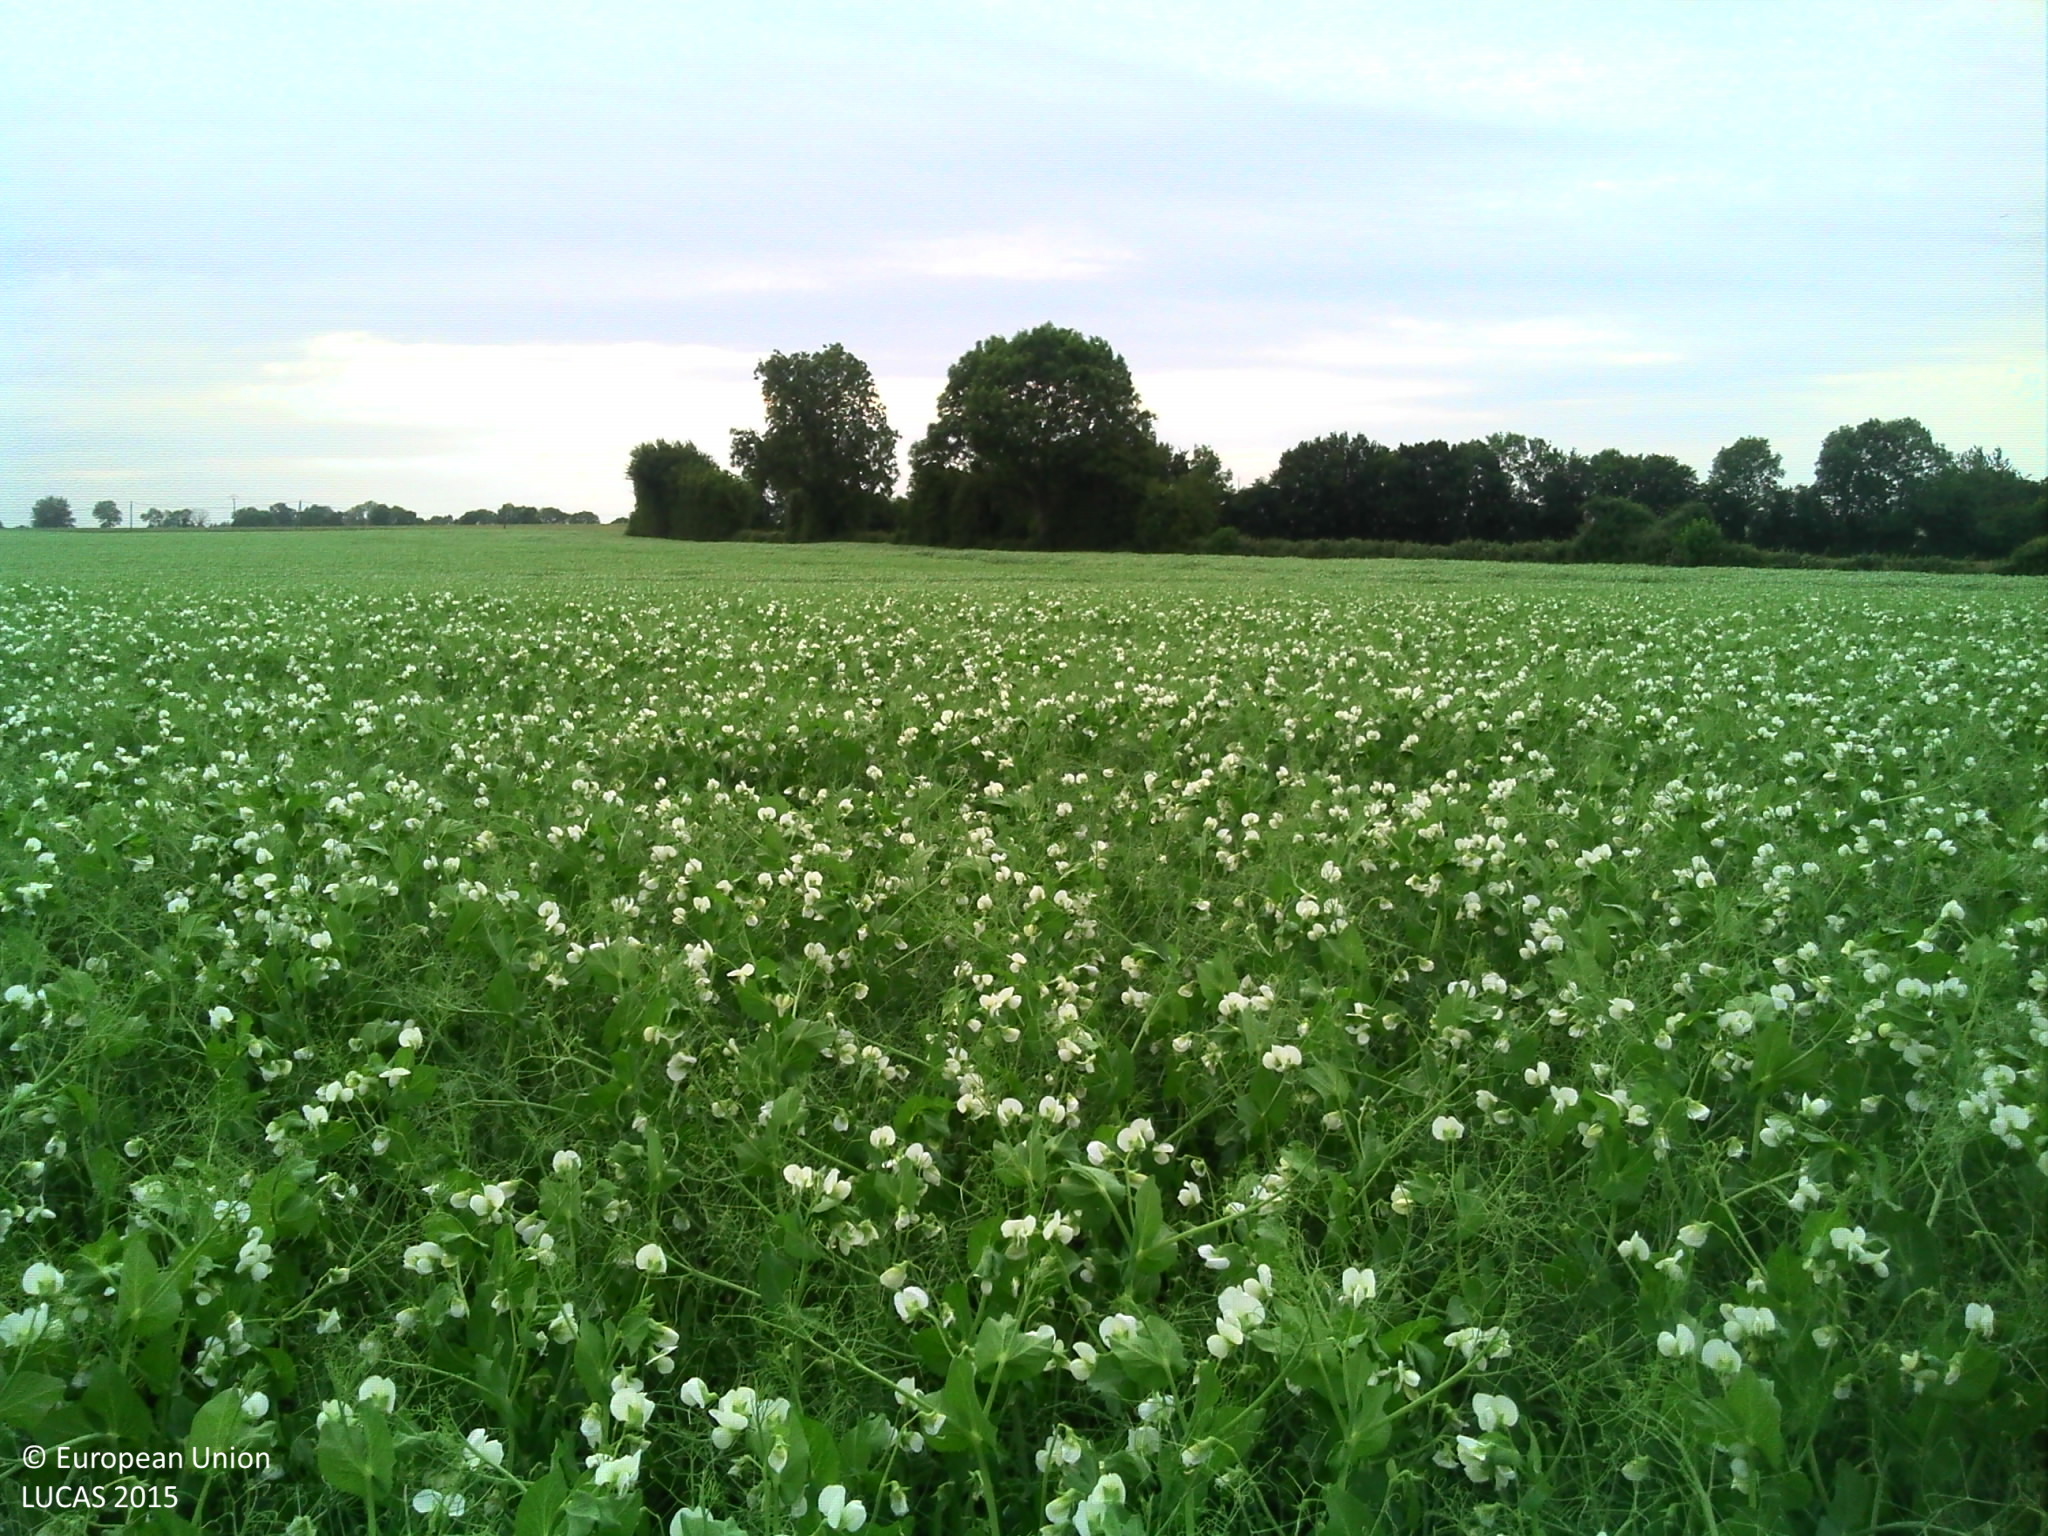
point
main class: Cropland
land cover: Dry pulses
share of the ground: > 75 %
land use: Agriculture (excluding fallow land and kitchen gardens)
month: June
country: FR
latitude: 48.5654
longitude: 0.2019
